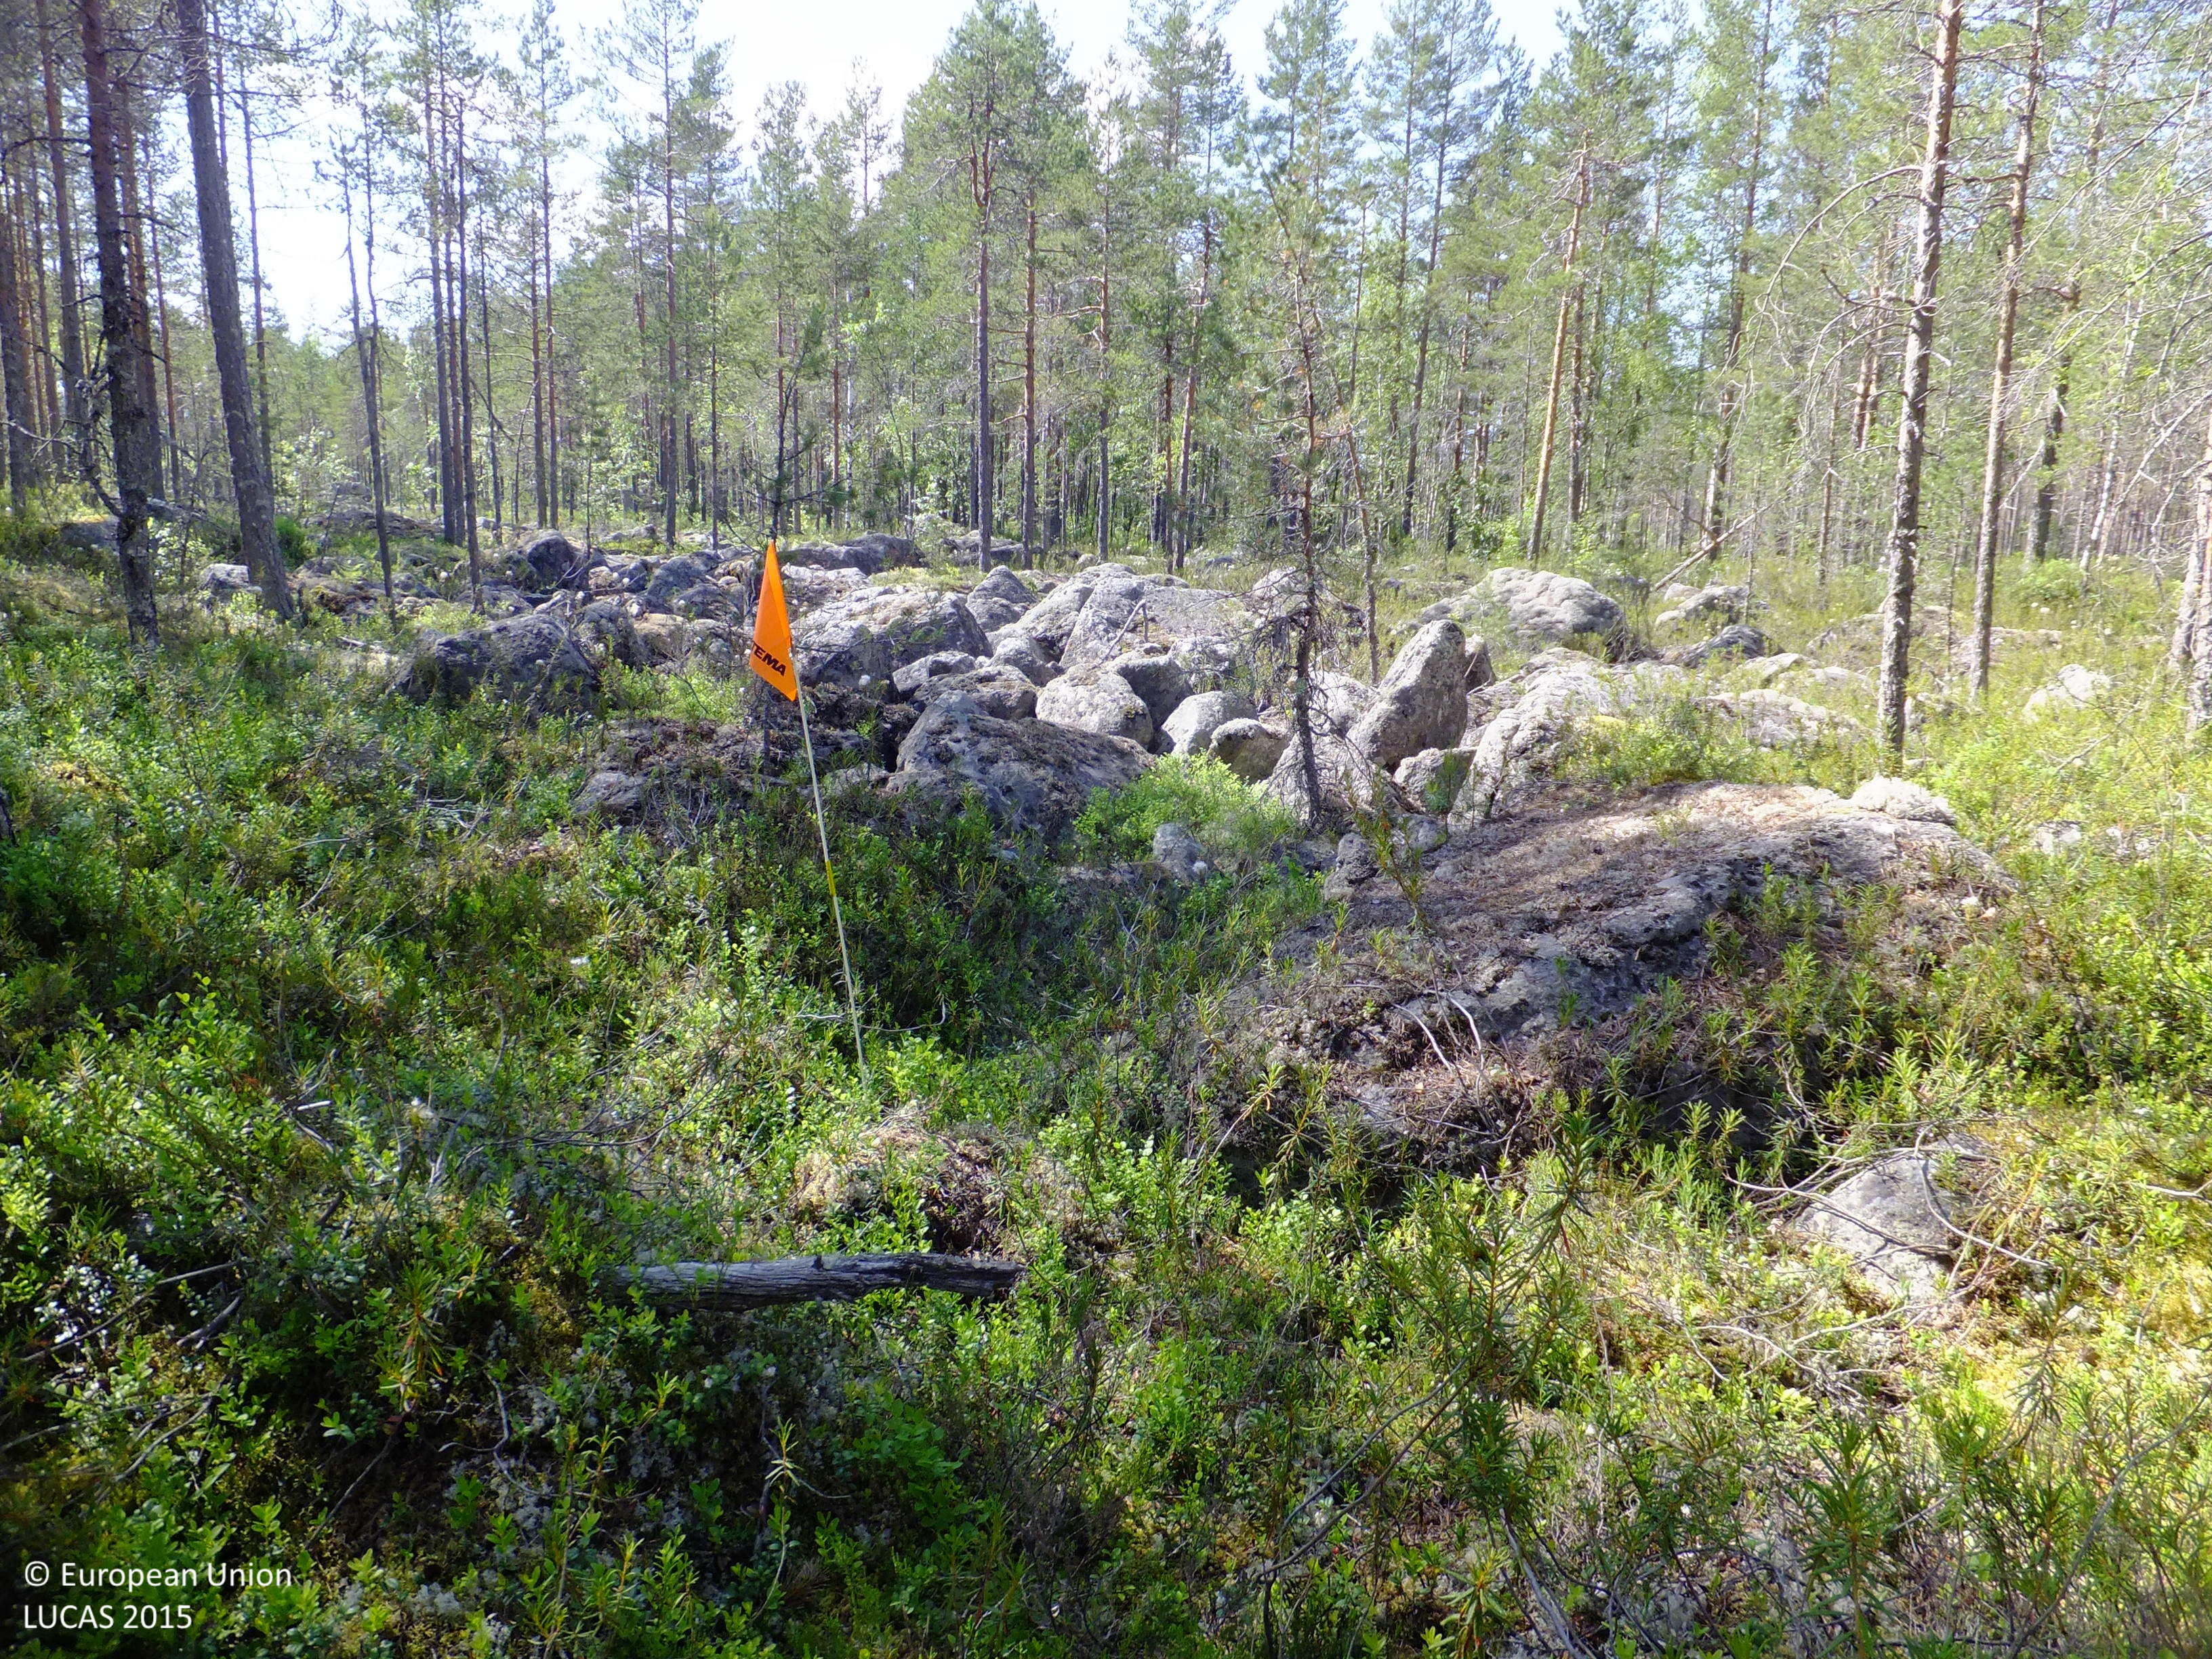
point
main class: Woodland
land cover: Pine dominated coniferous woodland
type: boreal forest
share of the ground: 25 - 50 %
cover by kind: coniferous forest trees 40 %, lichens and mosses 20 %, unconsolidated bare surface 20 %, shrubs 15 %, broadleaved forest trees 5 %
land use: Forestry
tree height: > 5 m
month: July
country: FI
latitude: 63.2869
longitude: 24.8647
